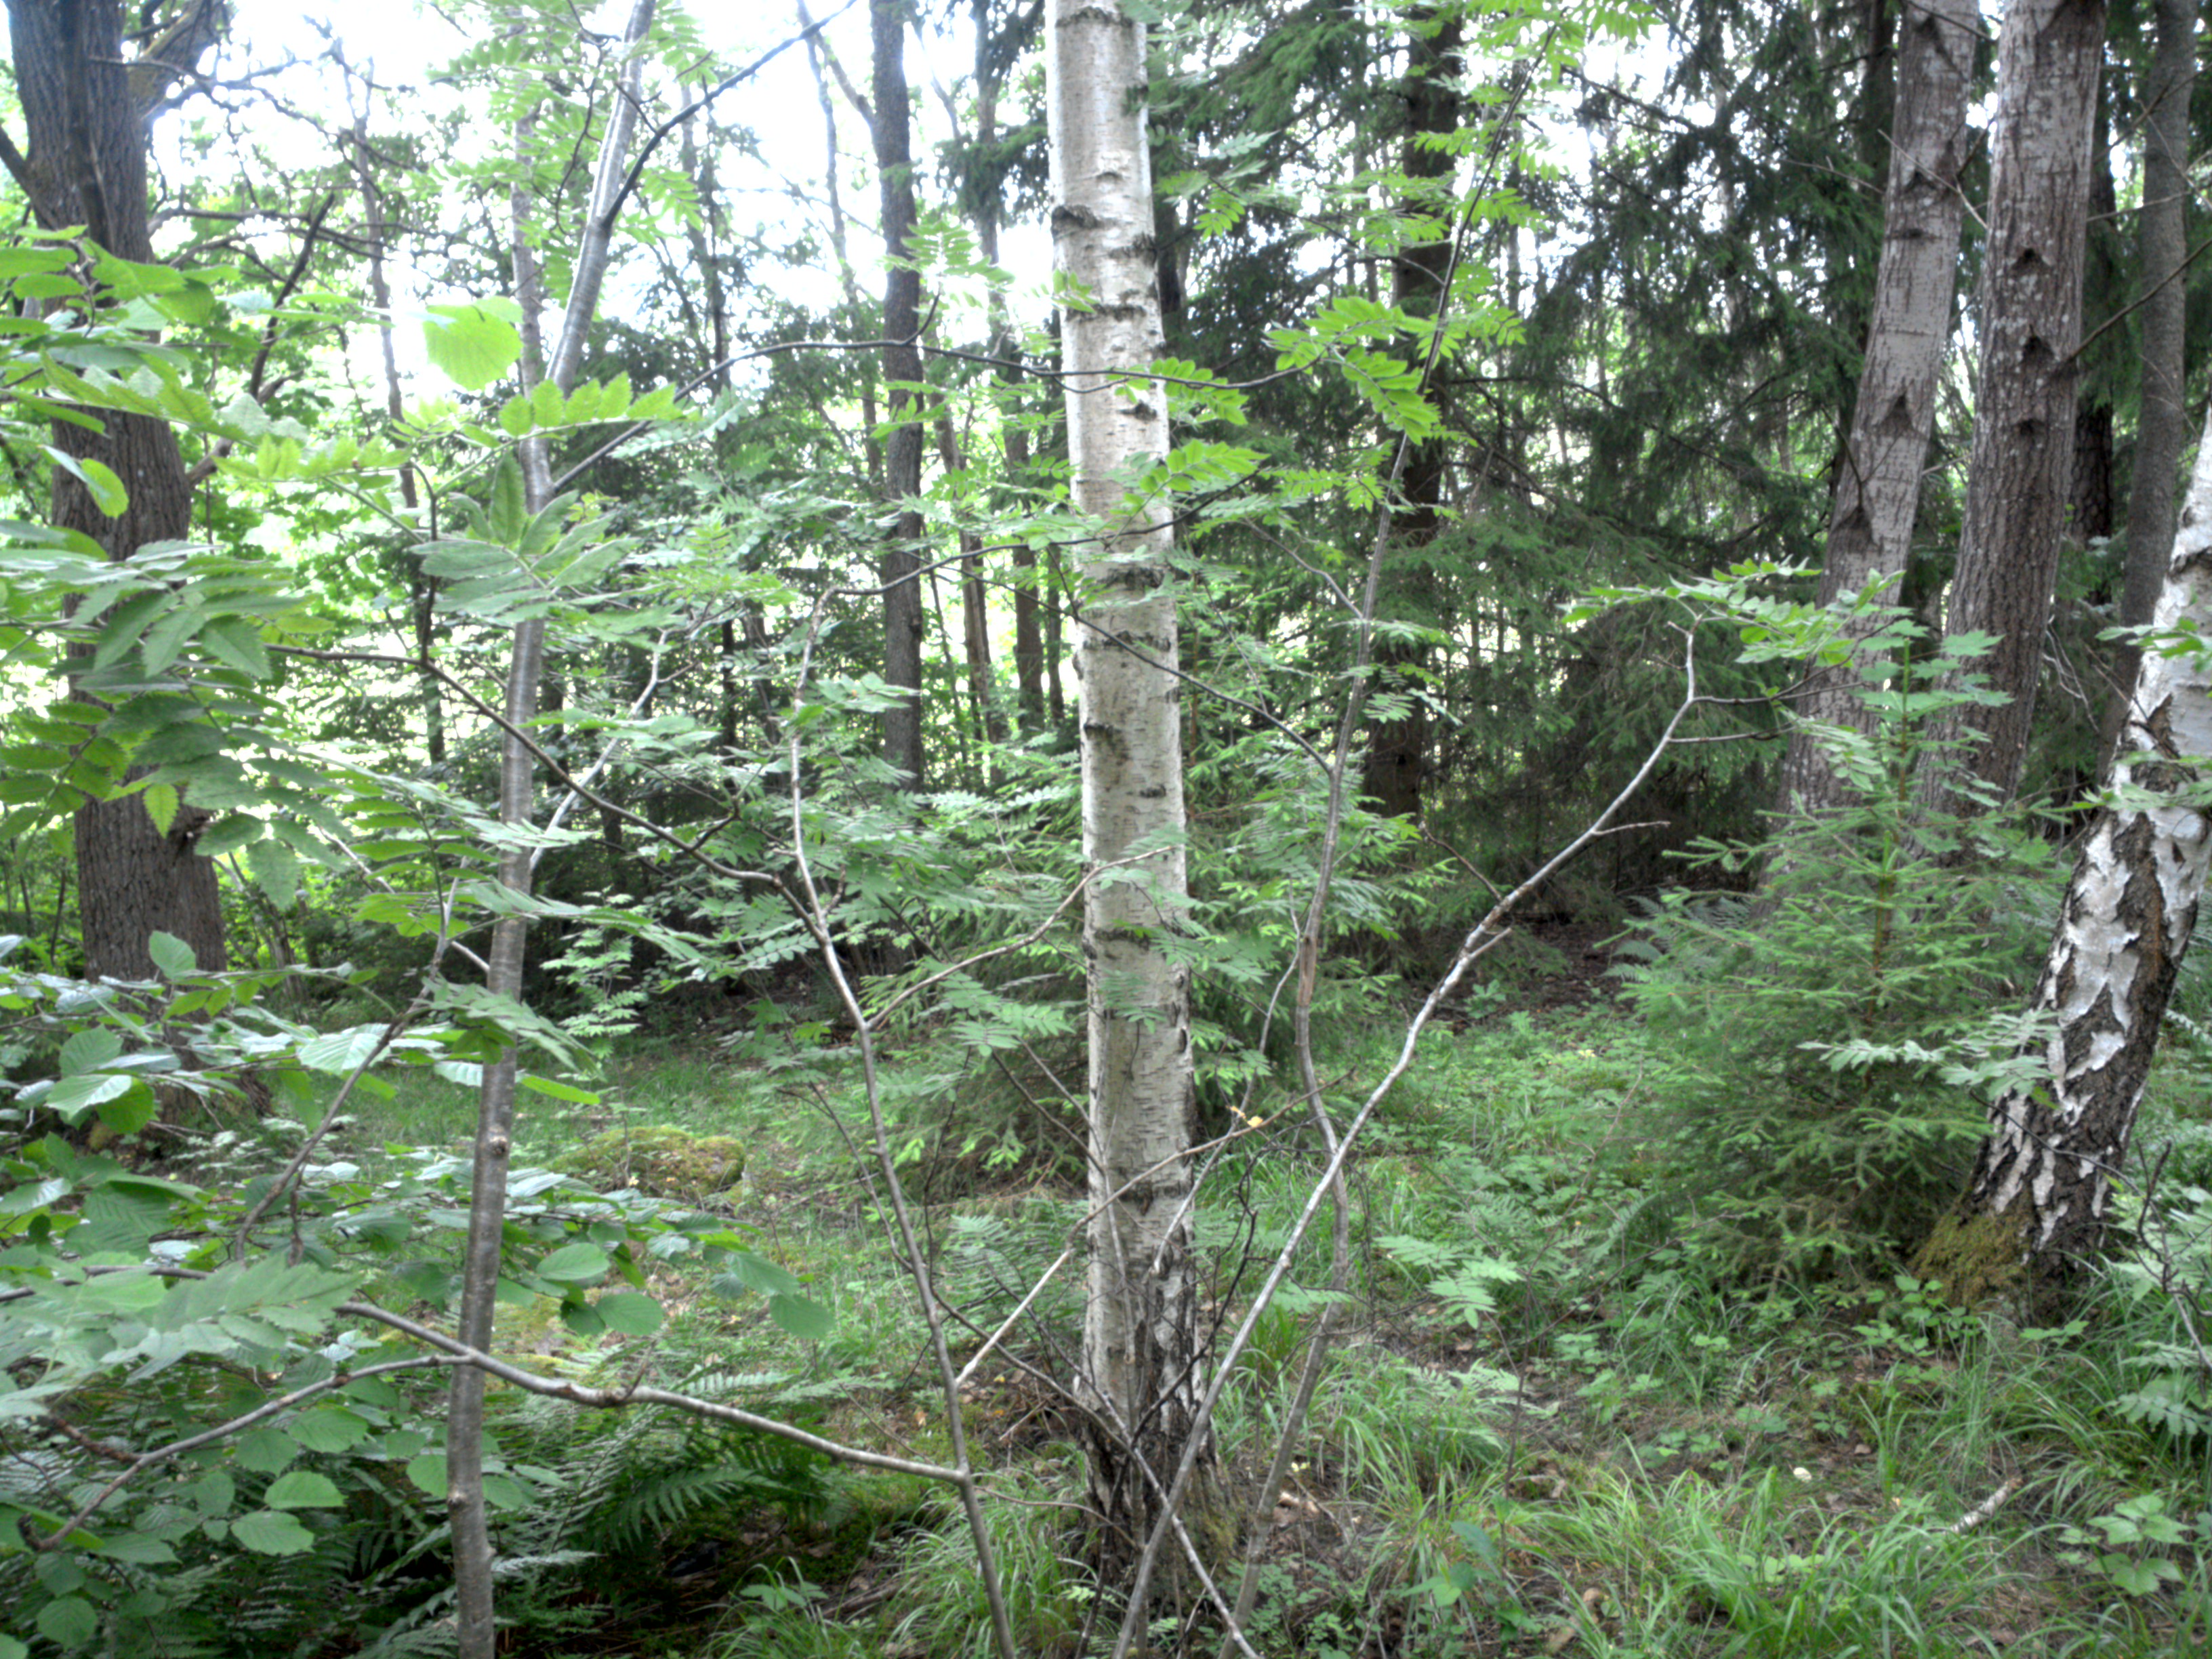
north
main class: Woodland
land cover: Broadleaved woodland
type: non-riverine alder, birch or aspen forest
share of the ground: 50 - 75 %
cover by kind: broadleaved forest trees 70 %, coniferous forest trees 10 %, shrubs 10 %, herbaceous plants 5 %, lichens and mosses 5 %
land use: Forestry
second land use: Amenities, museums, leisure
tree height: > 5 m
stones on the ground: < 10 %
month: June
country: SE
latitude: 59.2071
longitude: 17.7559
